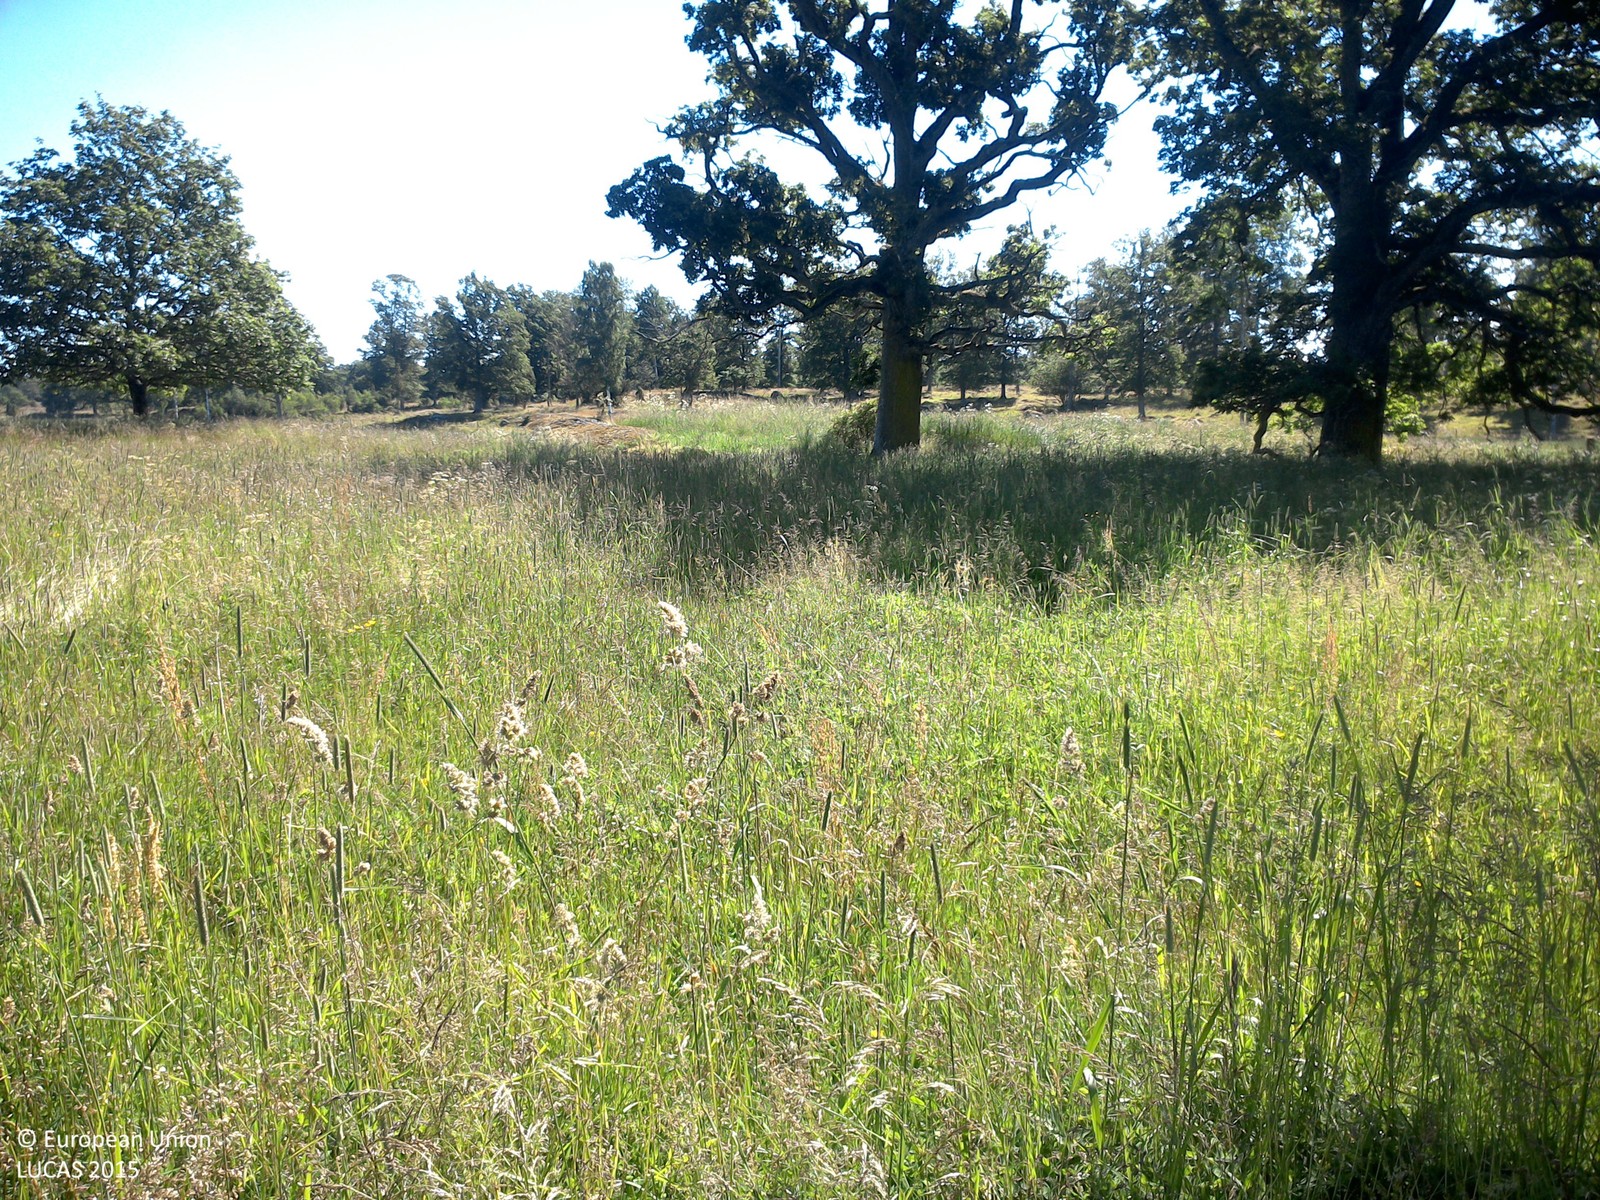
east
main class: Grassland
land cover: Grassland with sparse tree/shrub cover
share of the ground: > 75 %
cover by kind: herbaceous plants 95 %, broadleaved forest trees 5 %
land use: Agriculture (excluding fallow land and kitchen gardens)
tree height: > 5 m
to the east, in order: Grassland with sparse tree/shrub cover; Broadleaved woodland; Grassland with sparse tree/shrub cover; Fences; Ditches and canals; Clovers; Ditches and canals; Other leguminous and mixtures for fodder; Fences; Broadleaved woodland; Fences; Arable land (only in case pi)
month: July
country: SE
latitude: 58.4016
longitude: 15.3501
